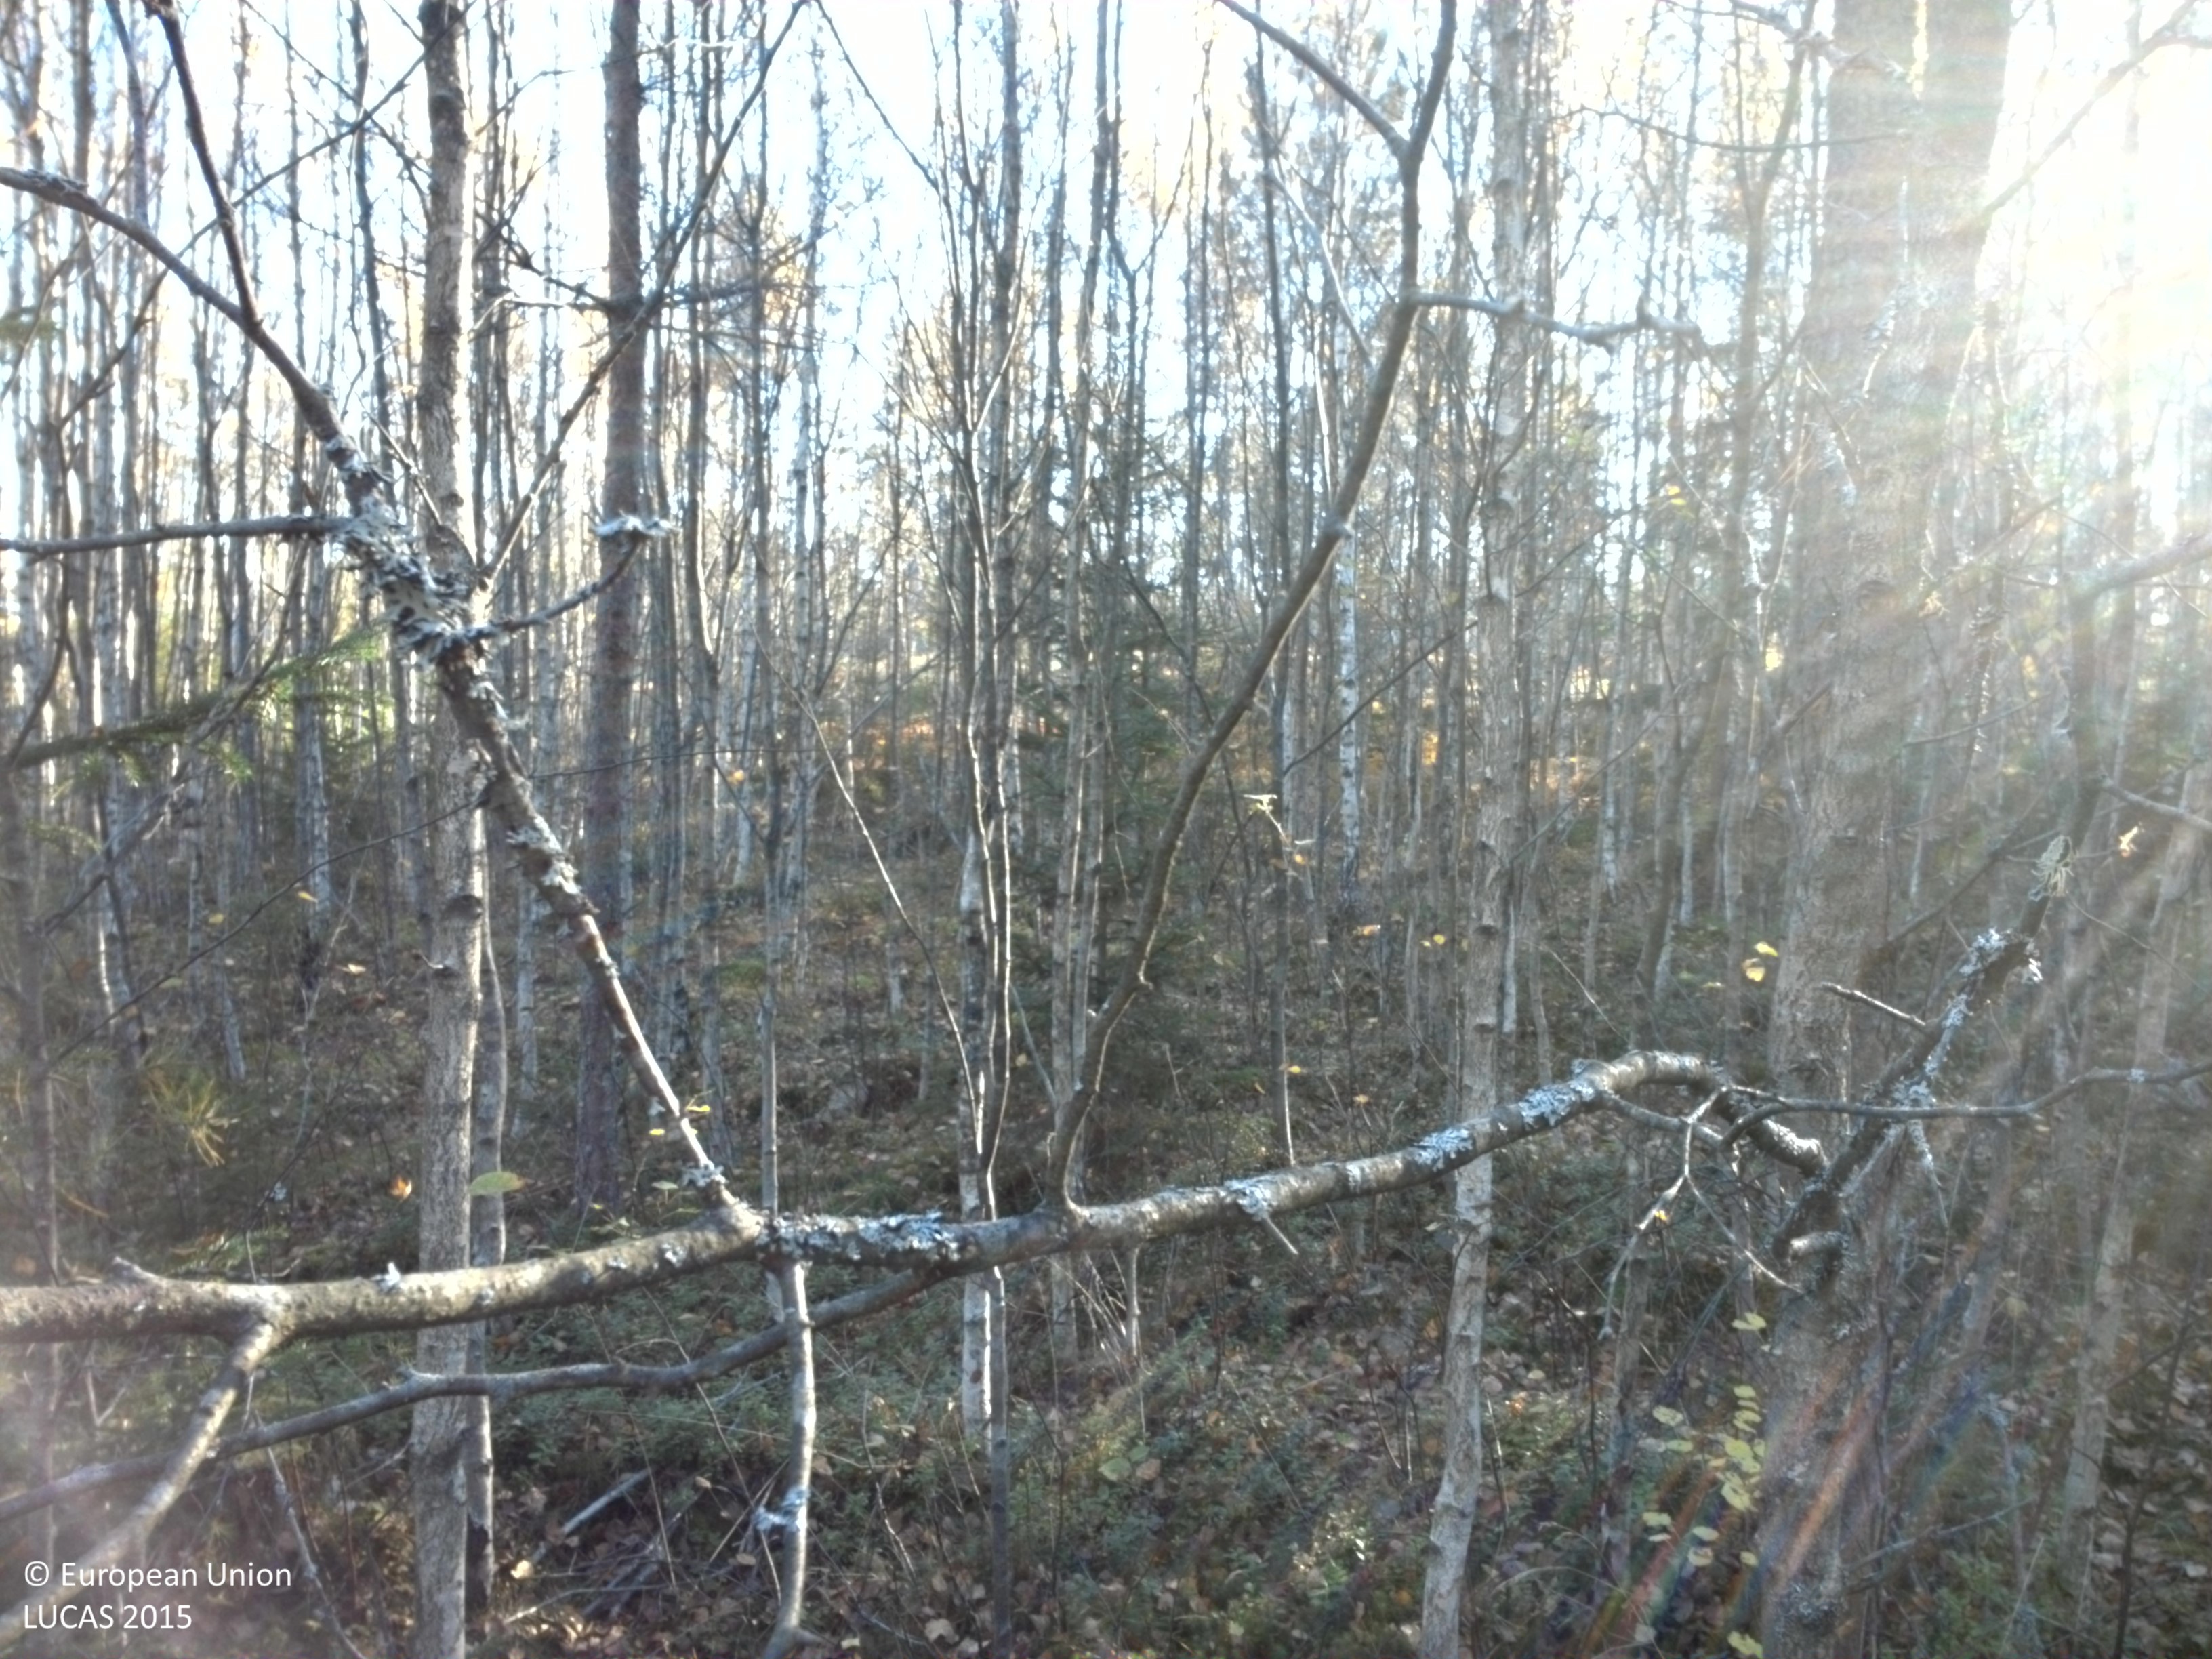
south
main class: Woodland
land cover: Spruce dominated mixed woodland
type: boreal forest
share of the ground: 25 - 50 %
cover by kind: broadleaved forest trees 35 %, herbaceous plants 20 %, lichens and mosses 20 %, coniferous forest trees 15 %, shrubs 10 %
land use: Forestry
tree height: > 5 m
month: October
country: SE
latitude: 59.1007
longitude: 13.1531
